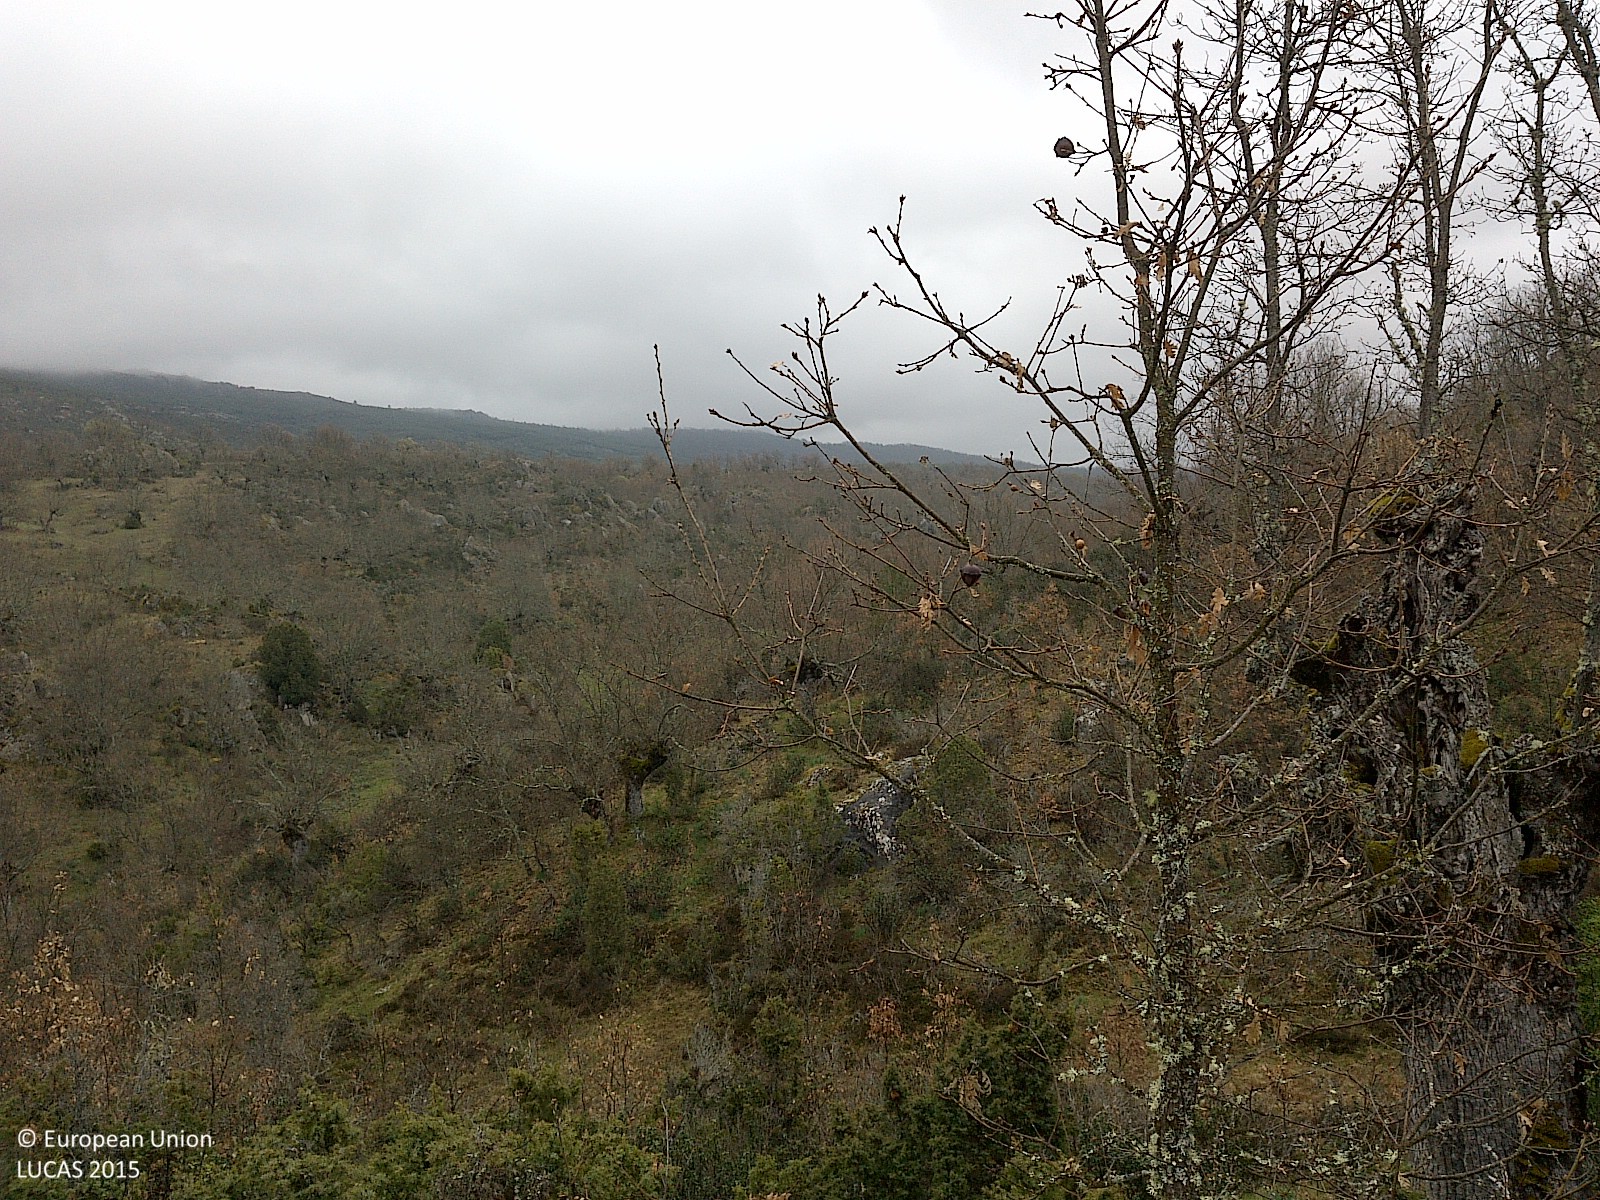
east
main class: Woodland
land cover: Broadleaved woodland
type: thermophilous deciduous forest
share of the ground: 25 - 50 %
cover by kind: shrubs 40 %, broadleaved forest trees 30 %, consolidated bare surface 15 %, herbaceous plants 10 %, coniferous forest trees 5 %
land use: Semi-natural and natural areas not in use
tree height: < 5 m
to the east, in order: Broadleaved woodland; Grassland with sparse tree/shrub cover; Broadleaved woodland; Shrubland with sparse tree cover; Broadleaved woodland; Grass margins; Rivers and streams; Grass margins; Shrubland with sparse tree cover; Broadleaved woodland; Shrubland with sparse tree cover
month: May
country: ES
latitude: 41.9345
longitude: -3.1825
